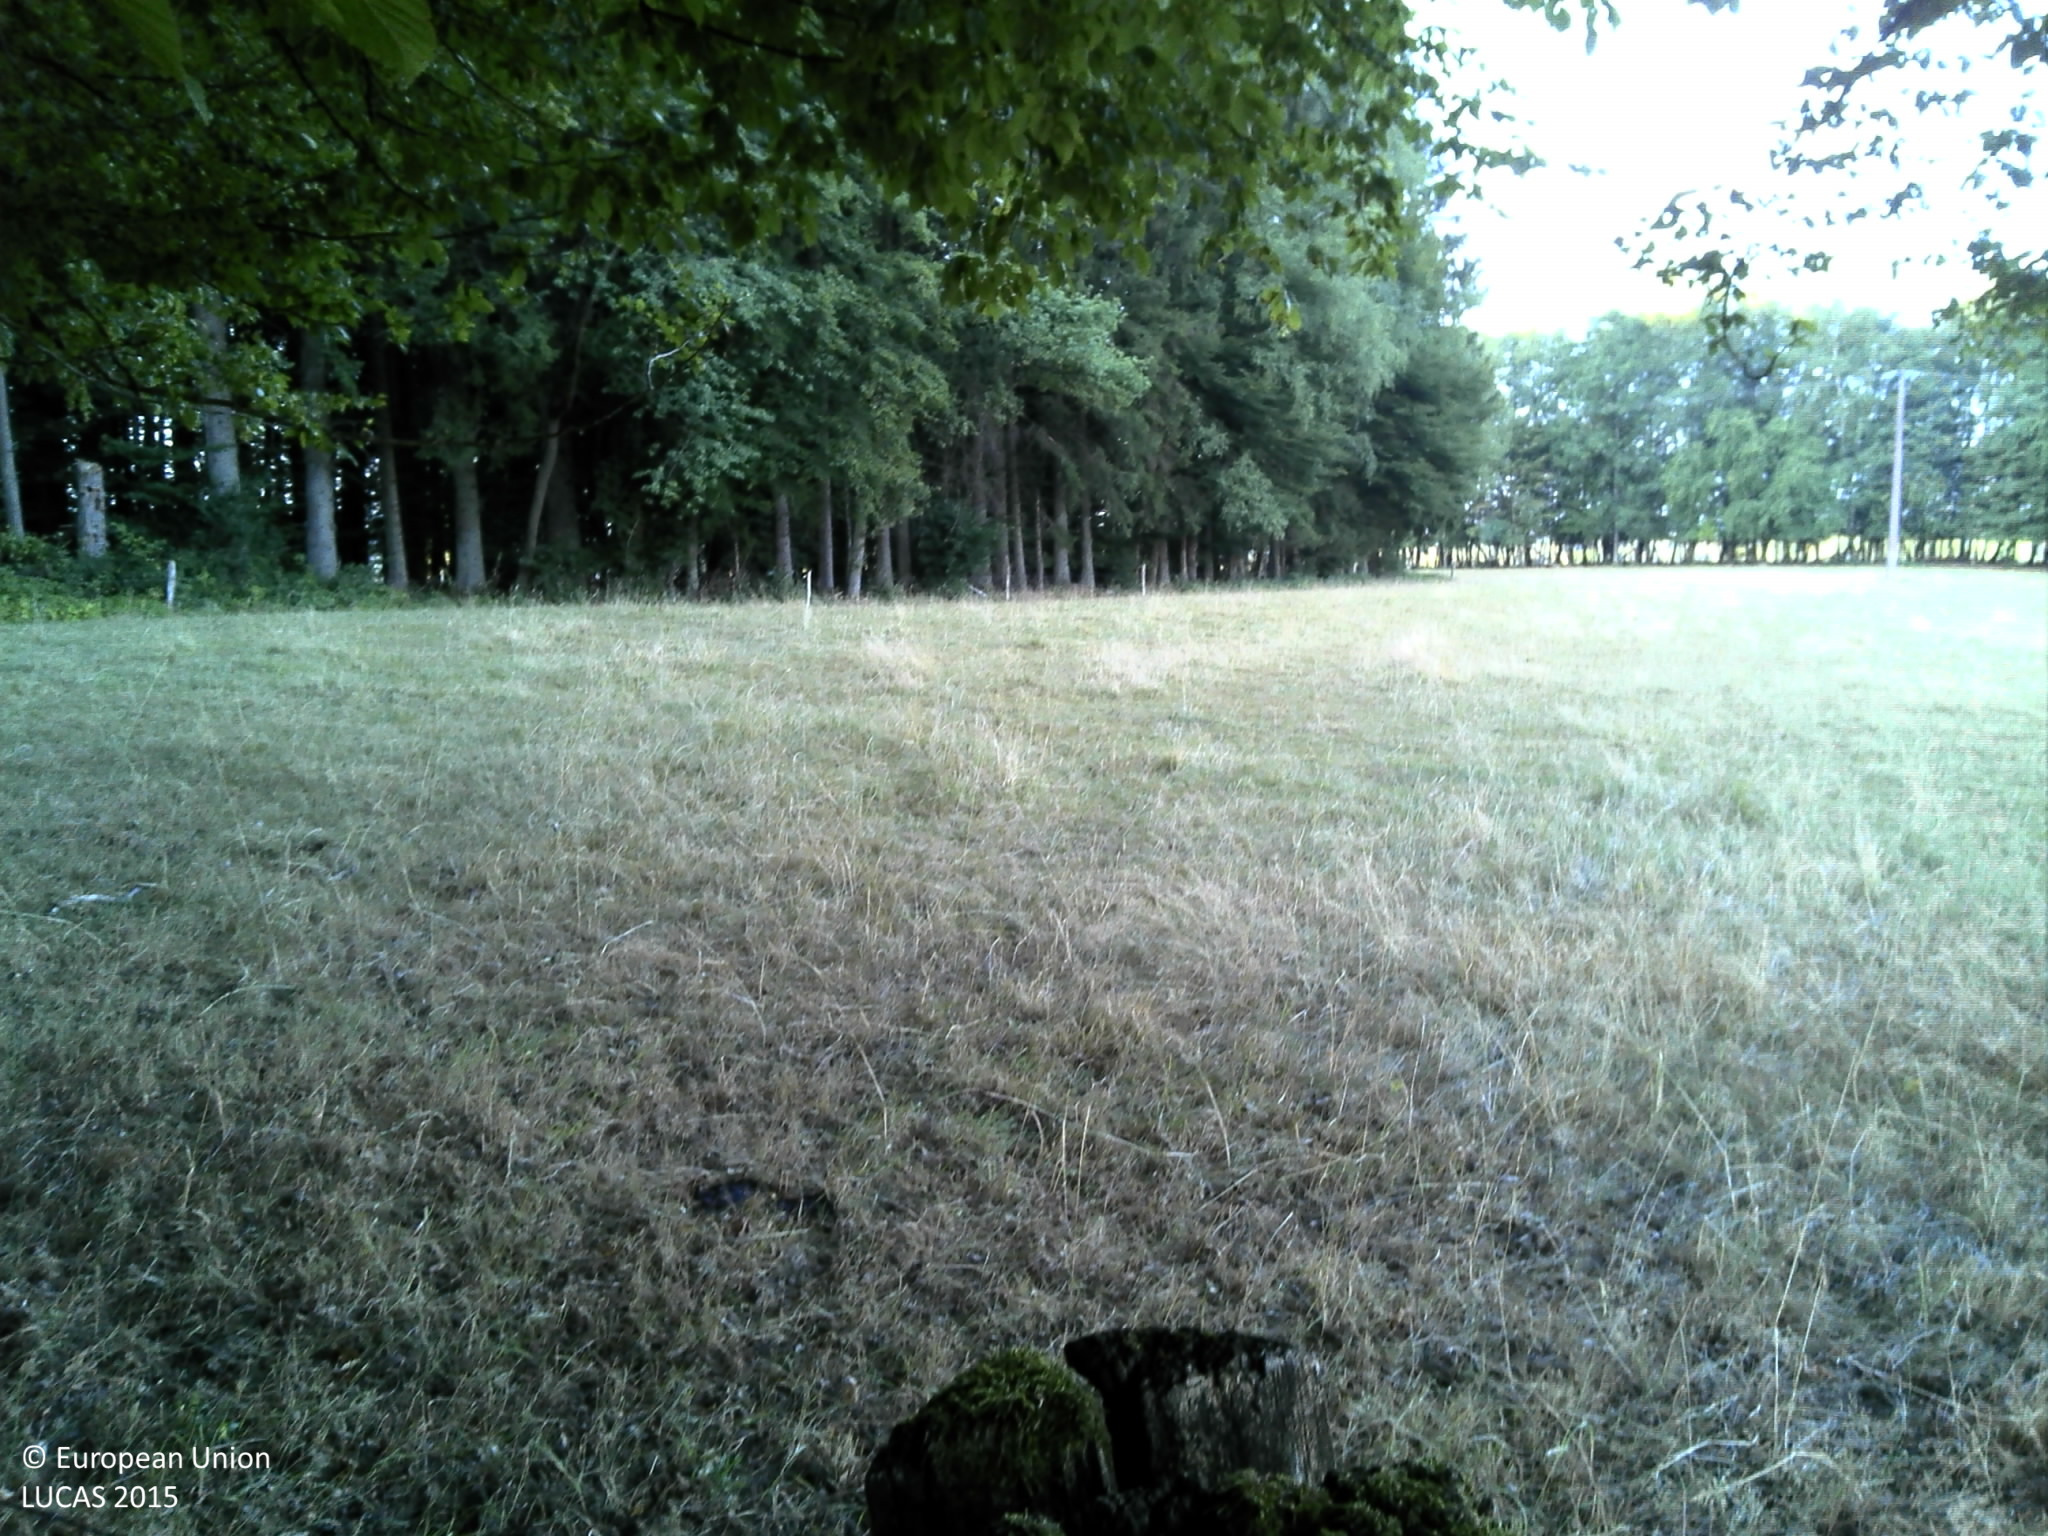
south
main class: Cropland
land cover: Oats
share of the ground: < 10 %
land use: Agriculture (excluding fallow land and kitchen gardens)
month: July
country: FR
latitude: 48.0160
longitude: 6.2603
